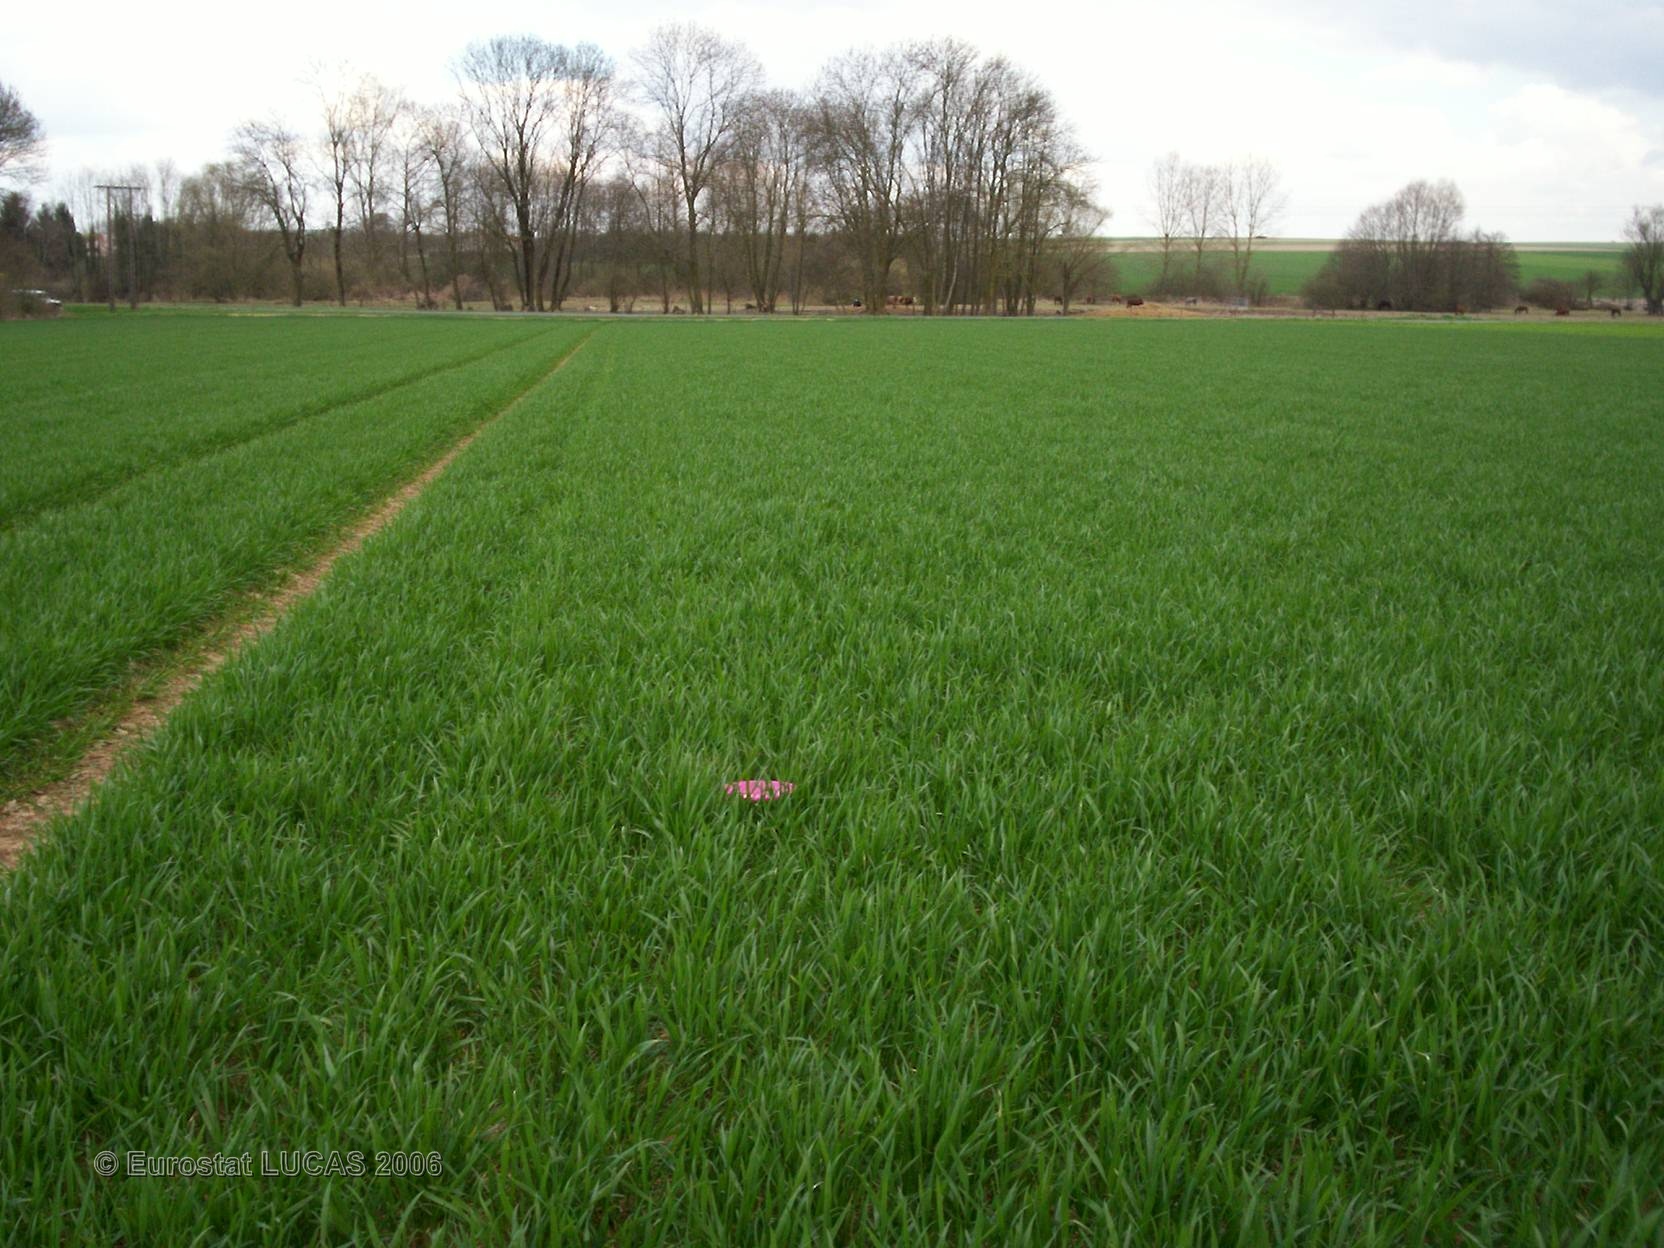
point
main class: Cropland
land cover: Common wheat
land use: Agriculture (excluding fallow land and kitchen gardens)
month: April
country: FR
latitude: 49.2357
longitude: 4.4065
